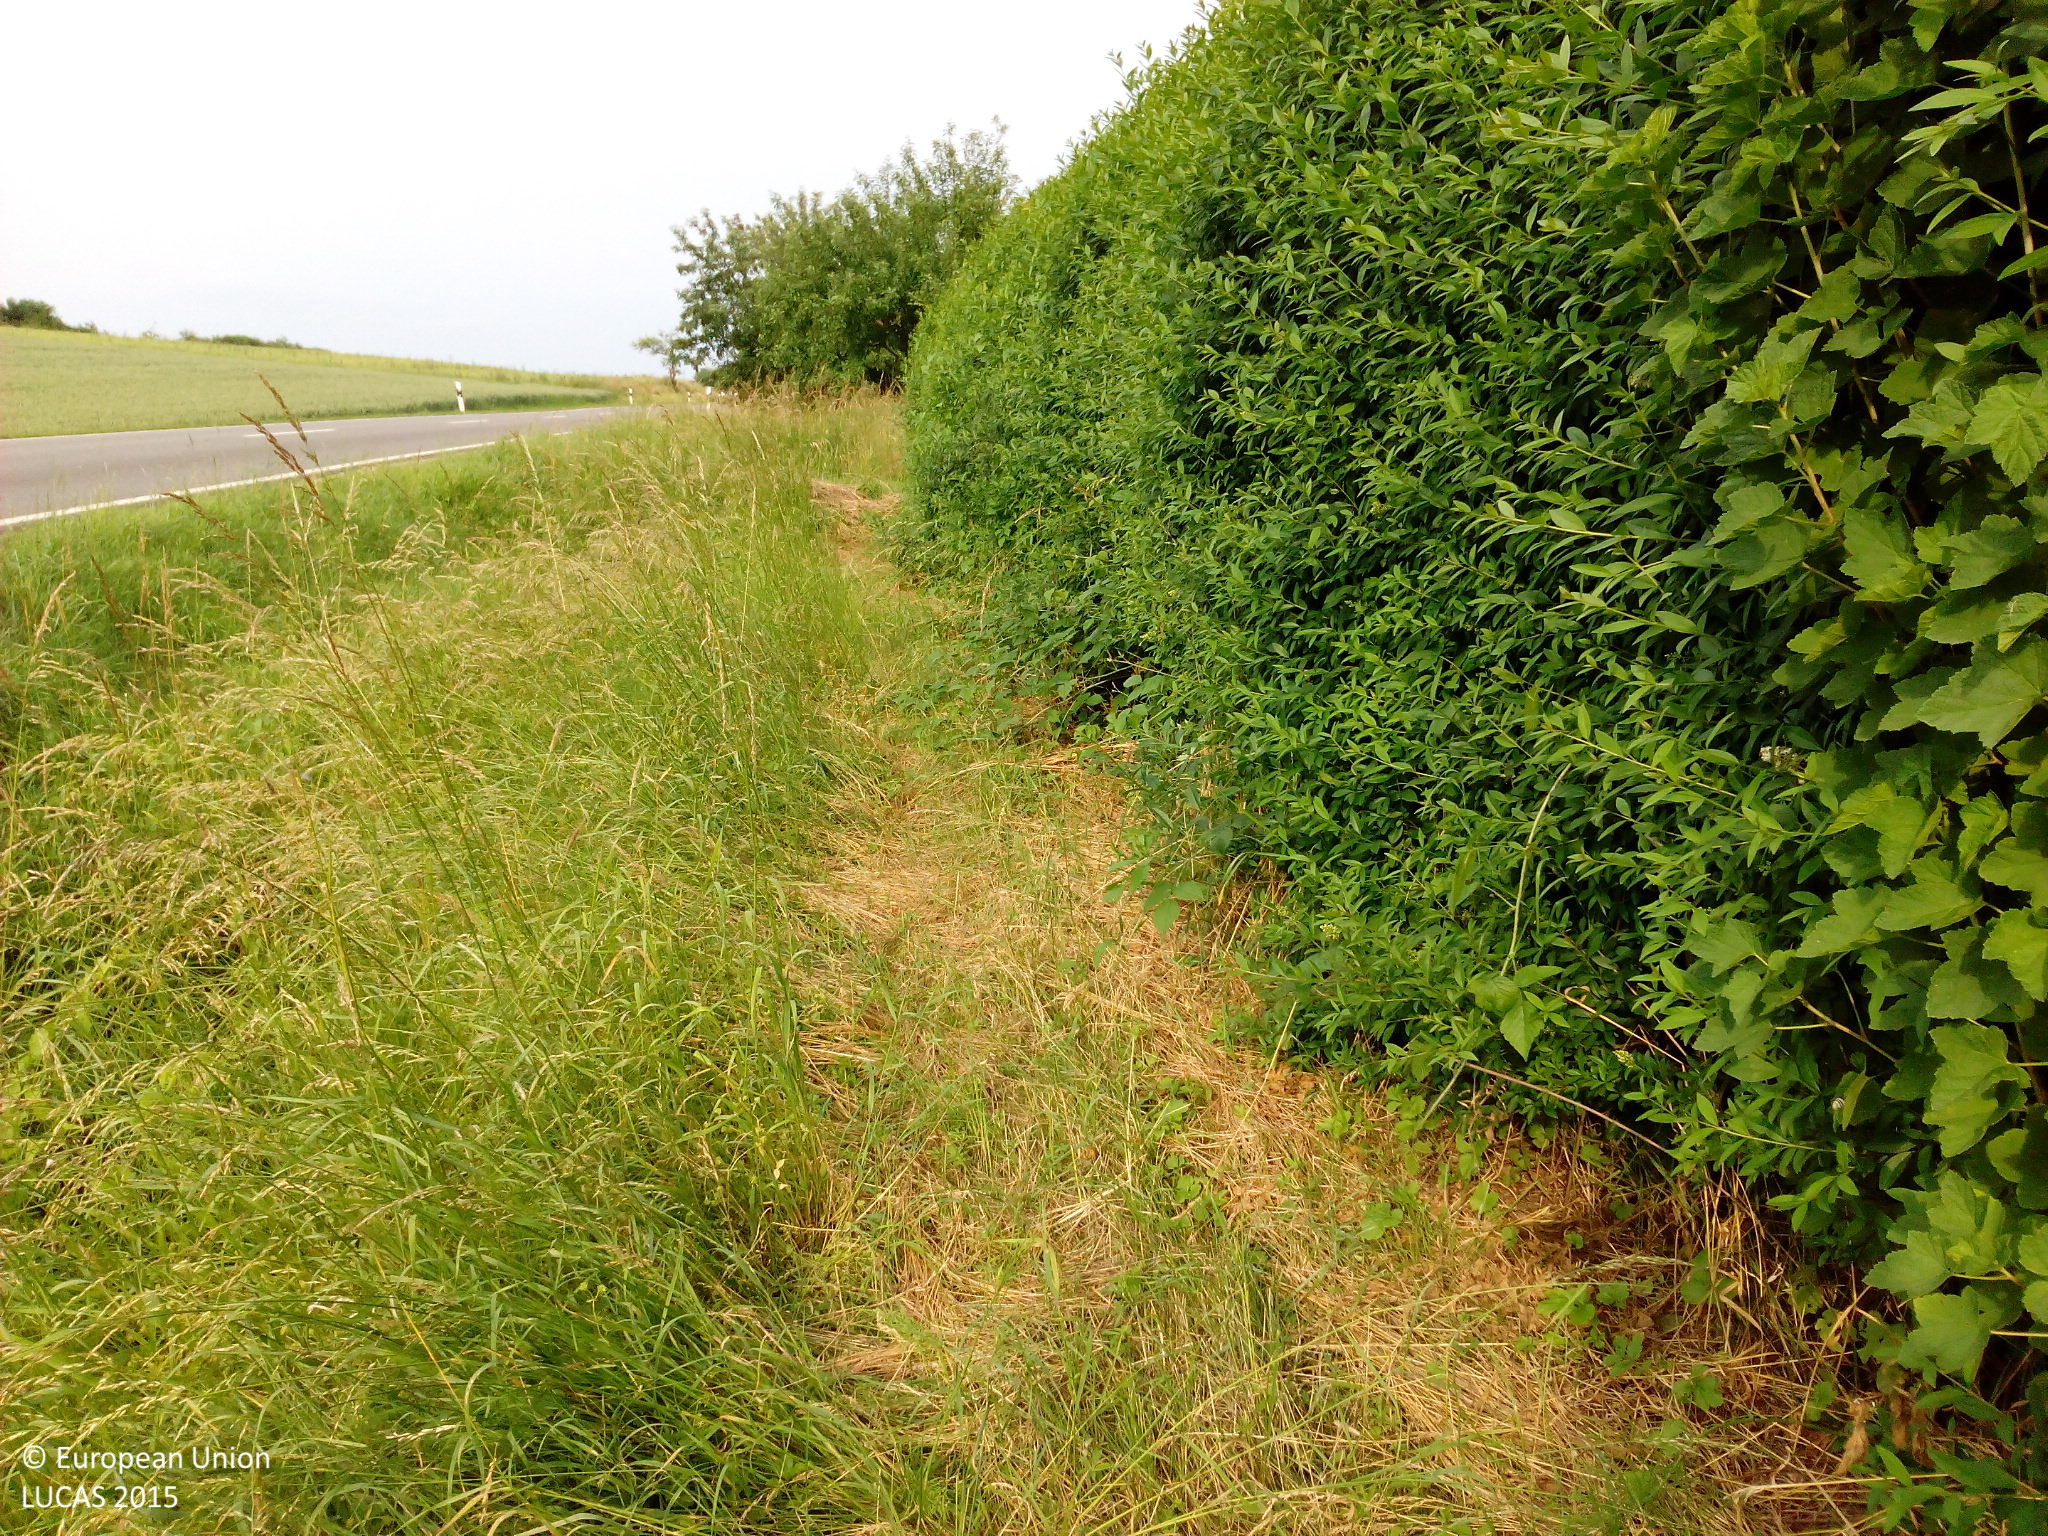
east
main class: Grassland
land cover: Grassland without tree/shrub cover
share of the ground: > 75 %
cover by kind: herbaceous plants 100 %
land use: Semi-natural and natural areas not in use
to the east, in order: Grassland without tree/shrub cover; Managed hedges; Apple fruit; Grassland without tree/shrub cover; Maize
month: June
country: DE
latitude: 48.6358
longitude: 9.4168
